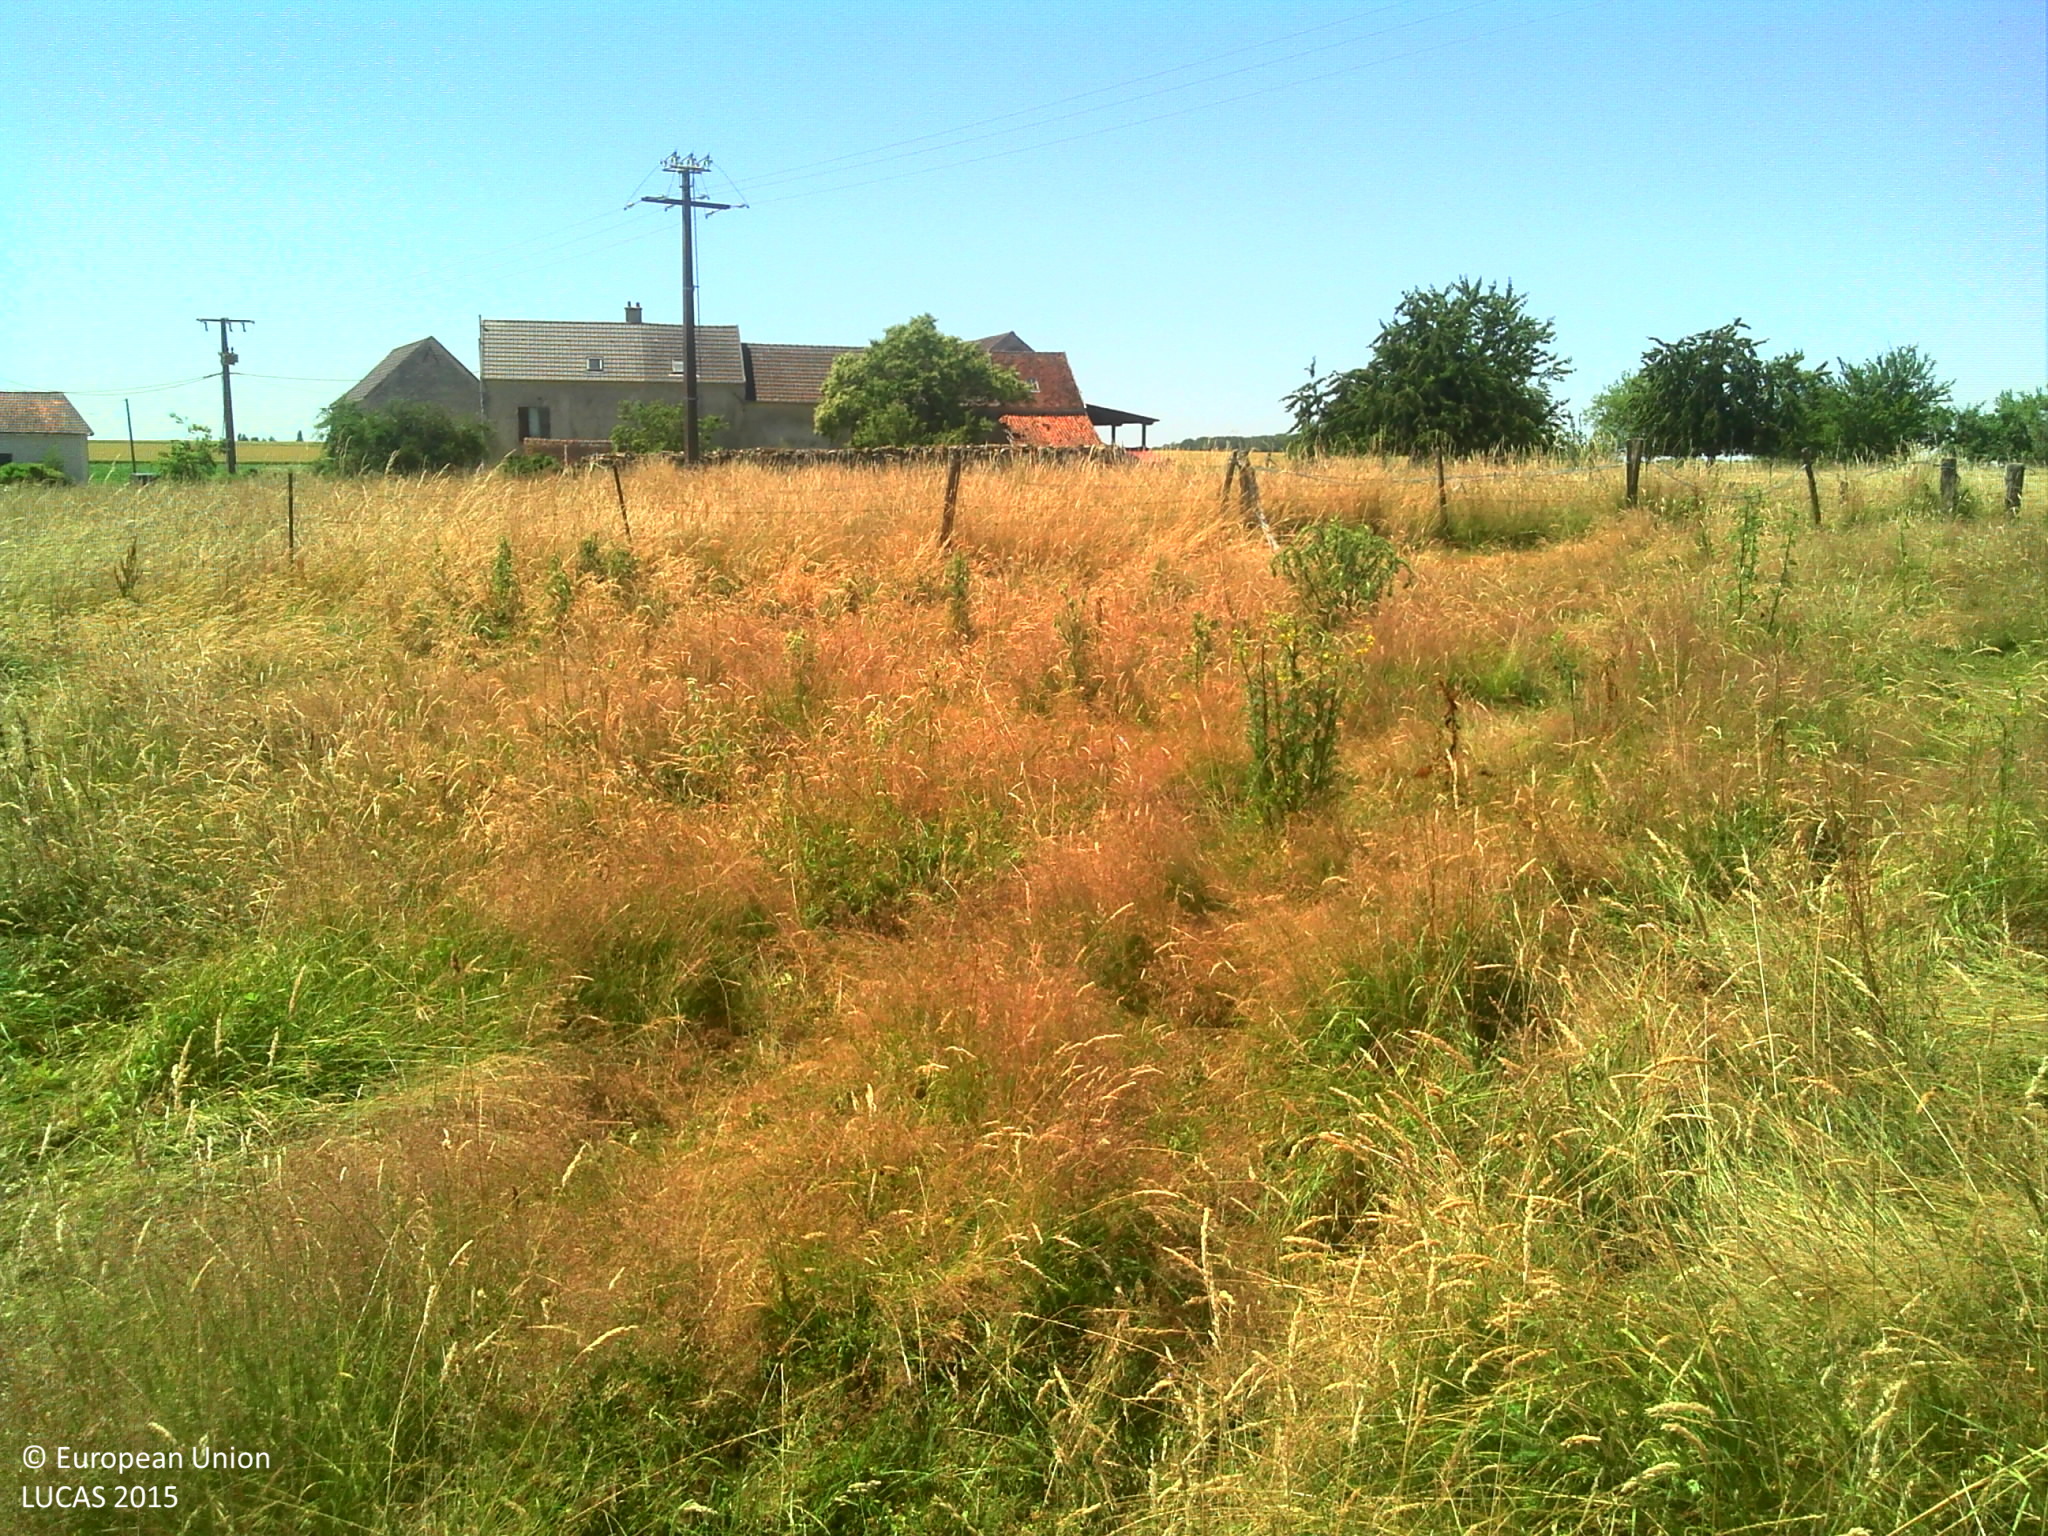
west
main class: Grassland
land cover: Grassland without tree/shrub cover
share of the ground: > 75 %
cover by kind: herbaceous plants 100 %
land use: Agriculture (excluding fallow land and kitchen gardens)
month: June
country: FR
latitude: 48.9413
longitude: 3.3164
